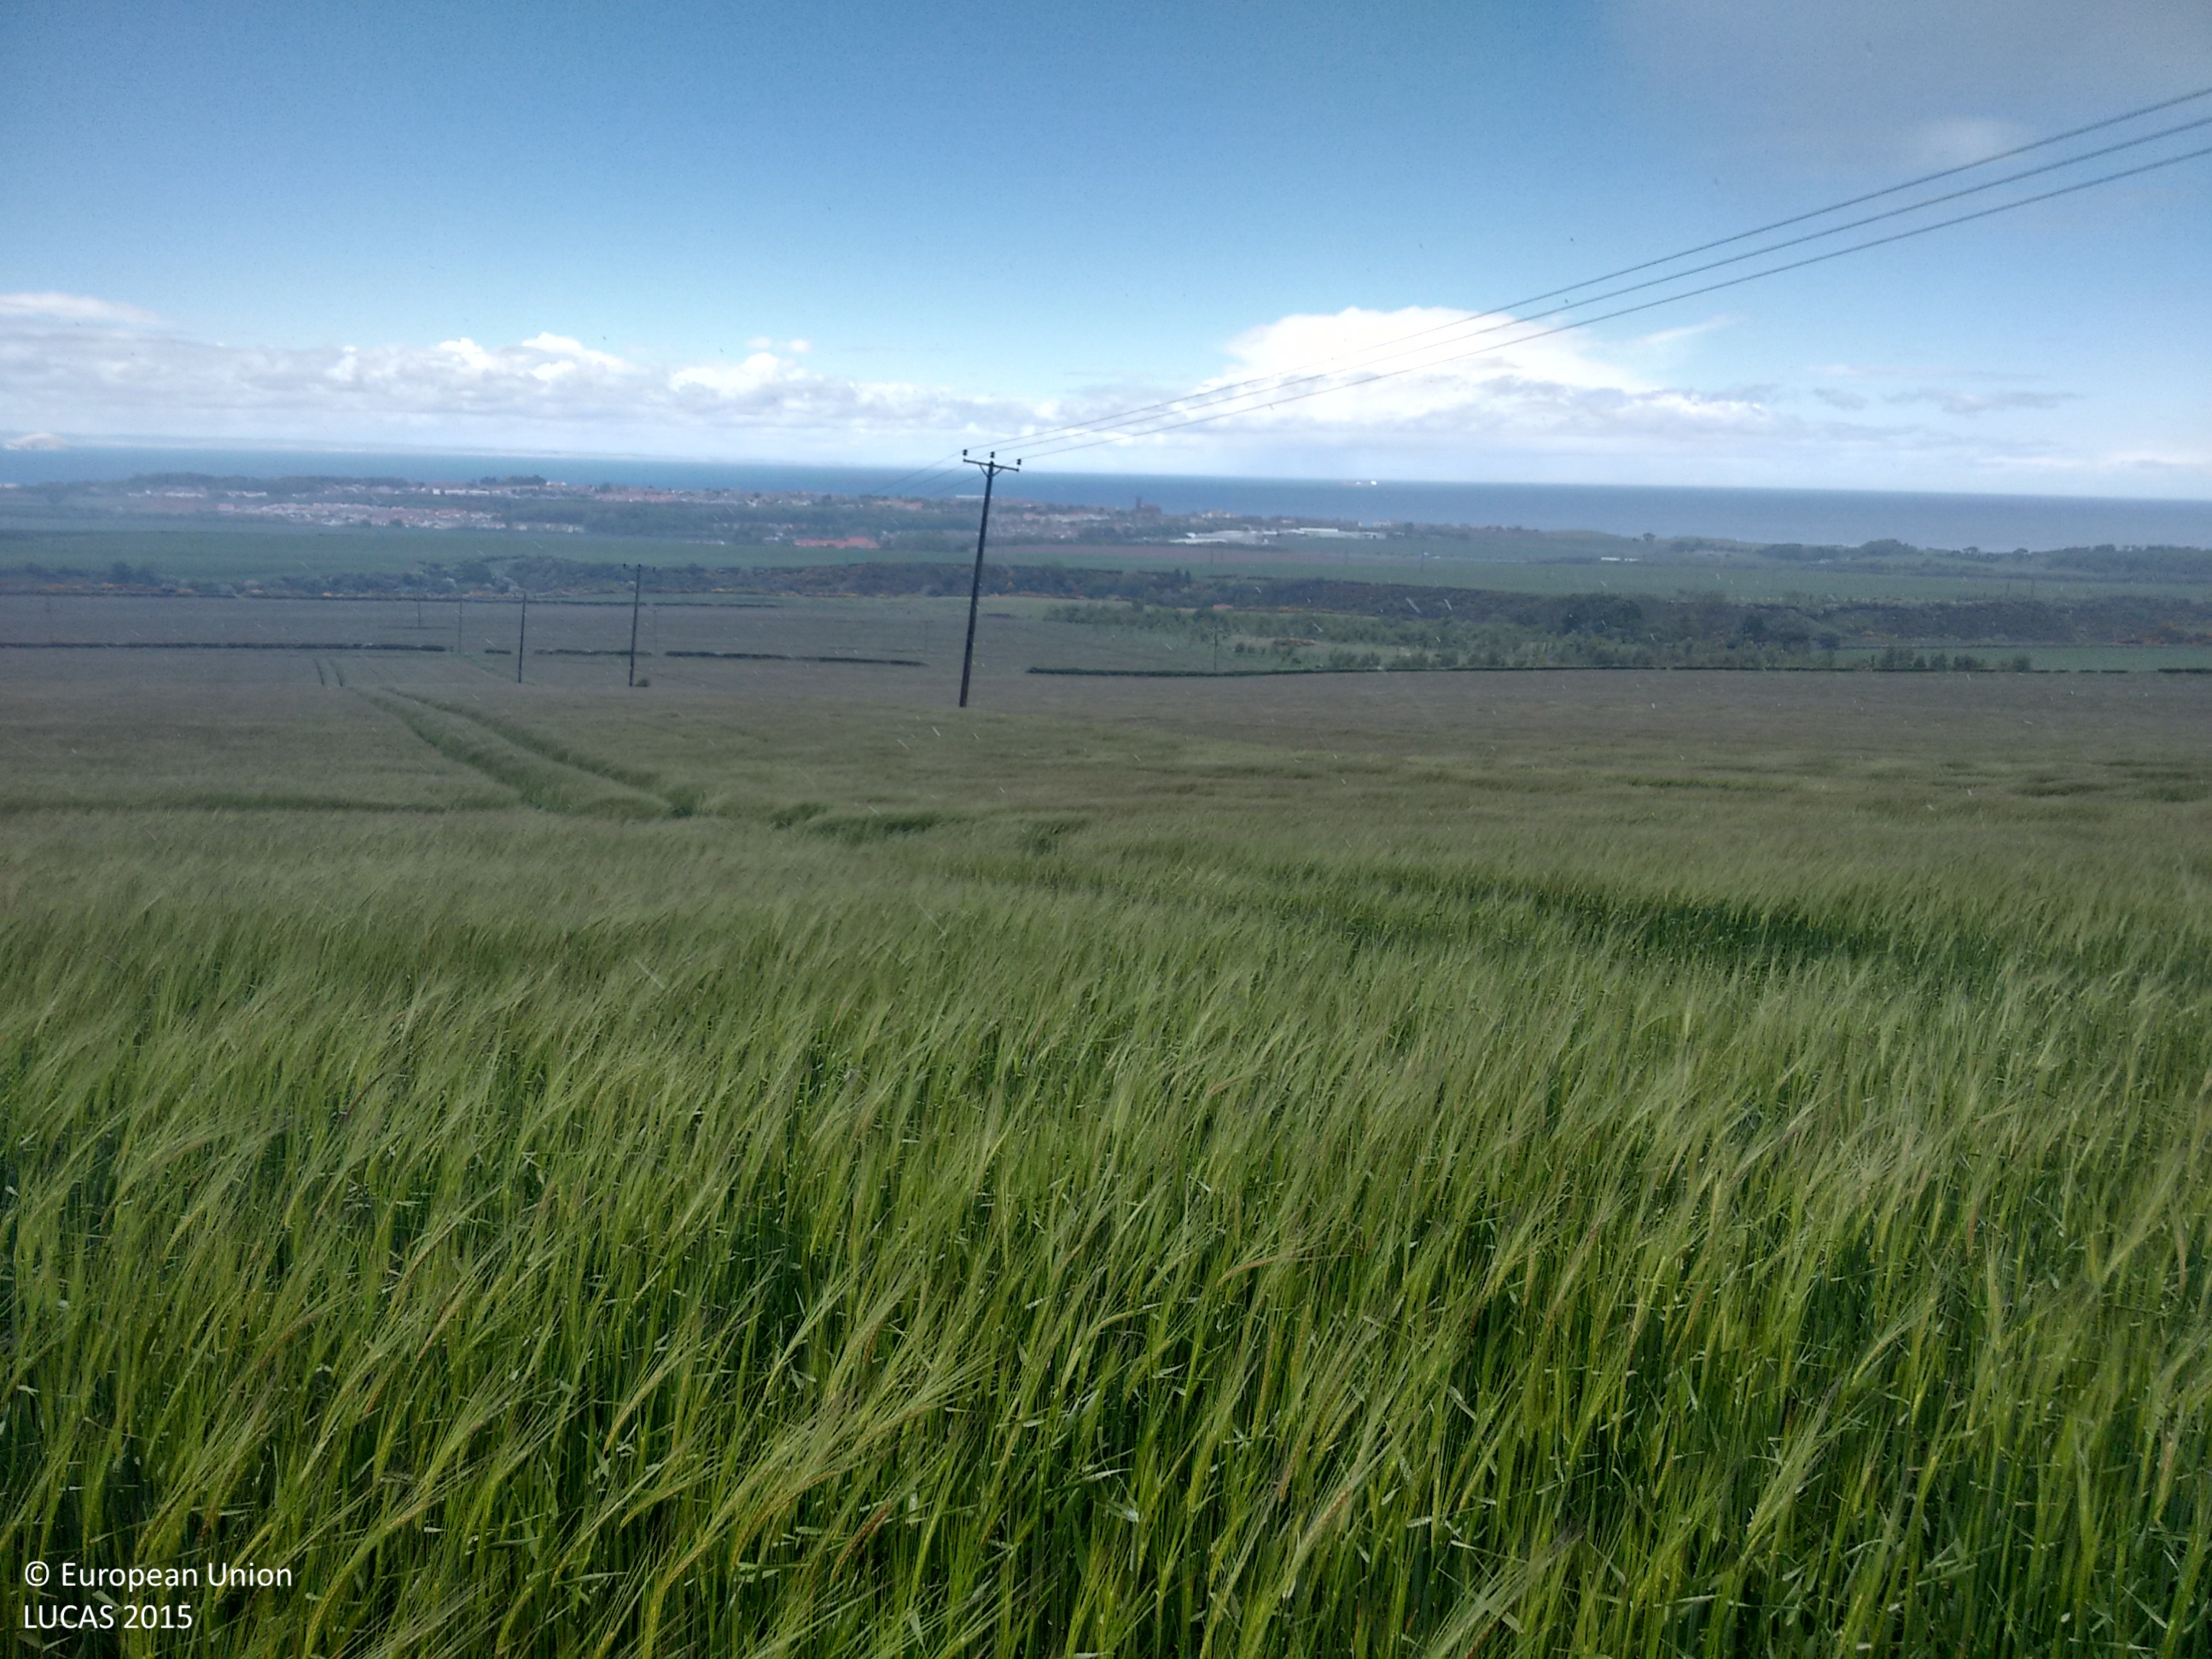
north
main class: Cropland
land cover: Barley
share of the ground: > 75 %
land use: Agriculture (excluding fallow land and kitchen gardens)
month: May
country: GB
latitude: 55.9734
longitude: -2.5099
